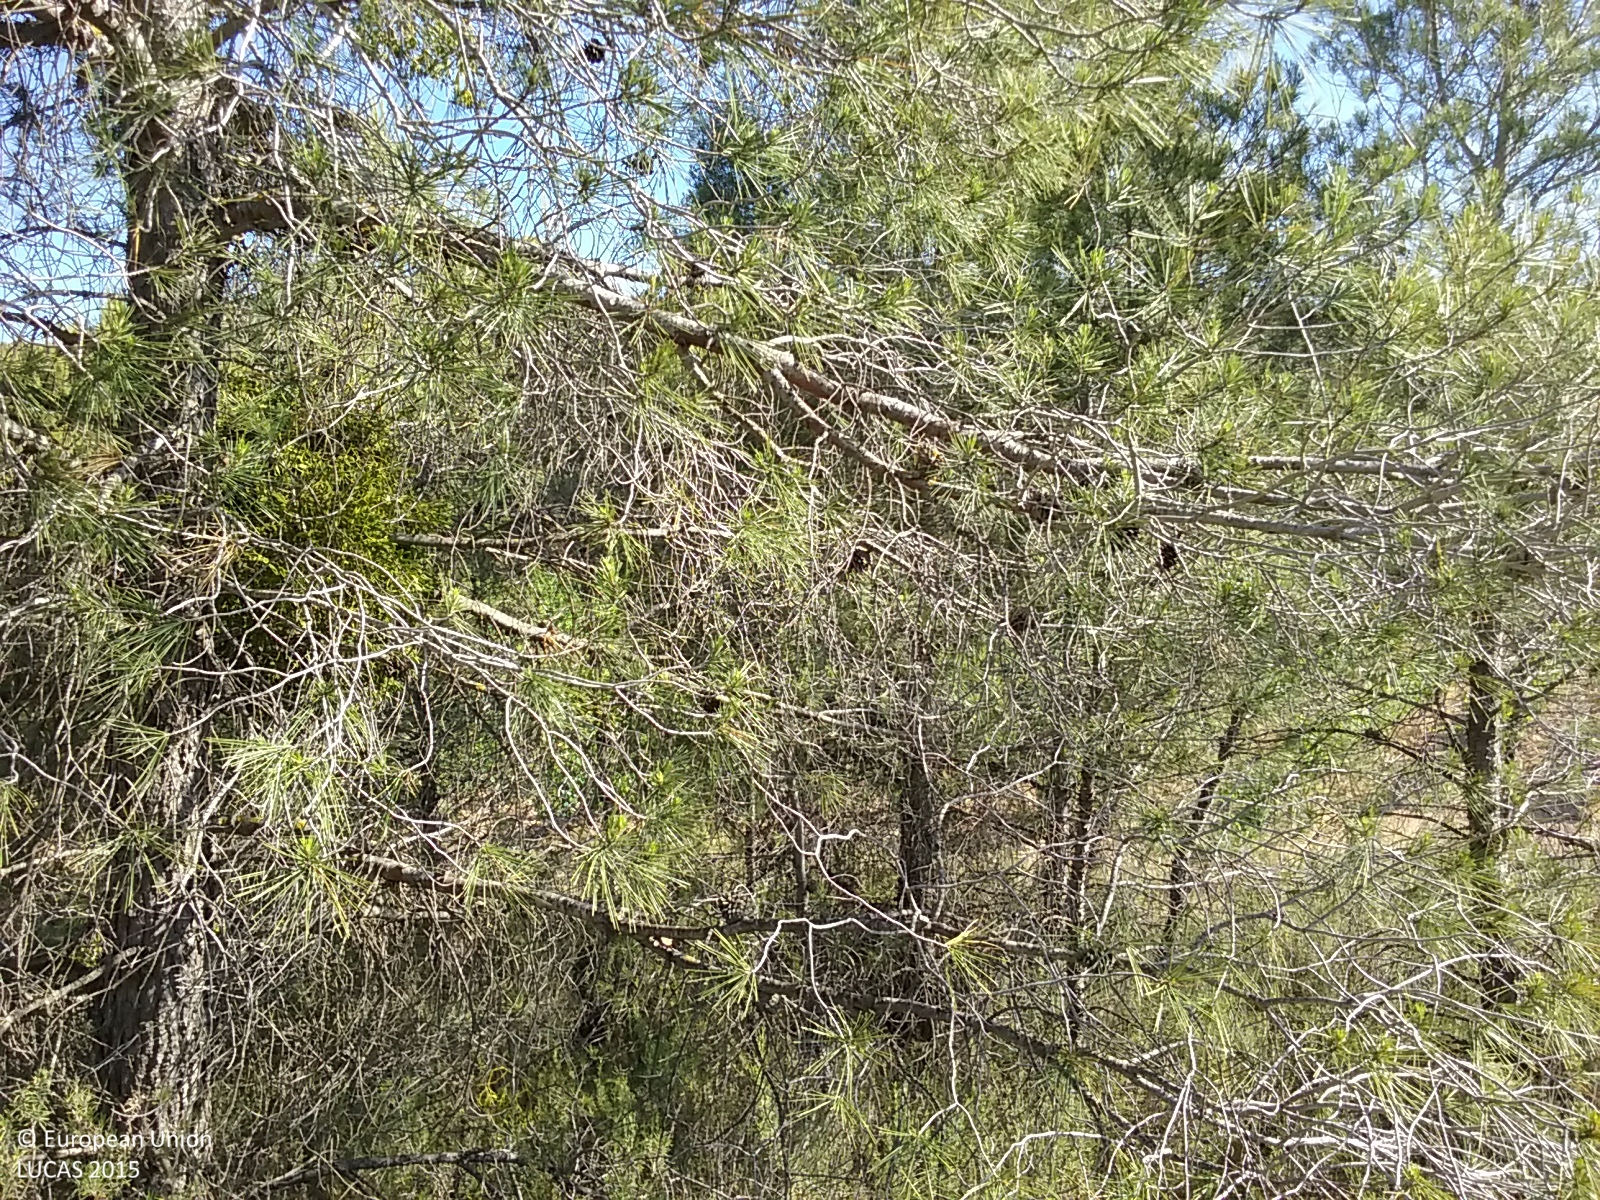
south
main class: Woodland
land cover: Pine dominated coniferous woodland
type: coniferous forest of the mediterranean region
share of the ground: 10 - 25 %
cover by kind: shrubs 65 %, coniferous forest trees 20 %, herbaceous plants 10 %, unconsolidated bare surface 5 %
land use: Semi-natural and natural areas not in use
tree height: > 5 m
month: June
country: ES
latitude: 41.0904
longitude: 0.2402
